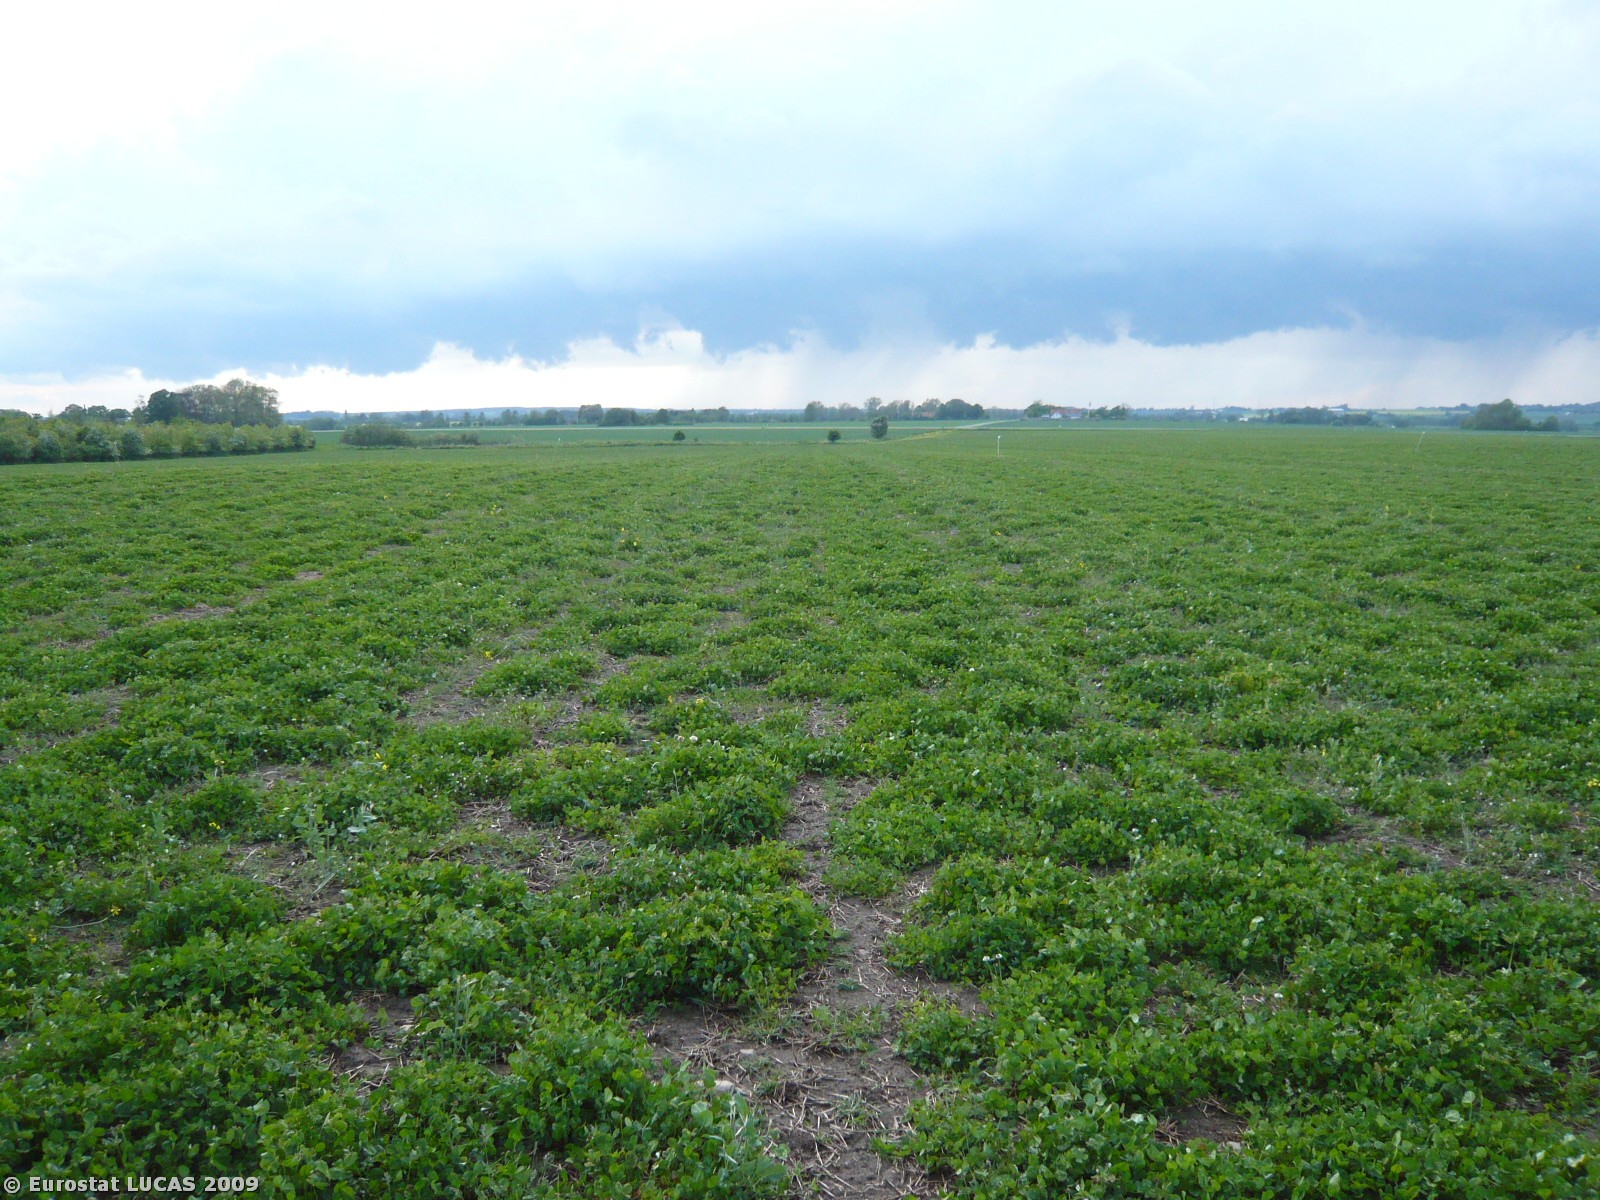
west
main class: Cropland
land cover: Clovers
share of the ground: > 75 %
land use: Agriculture (excluding fallow land and kitchen gardens)
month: May
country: DK
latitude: 55.4023
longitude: 11.7830
